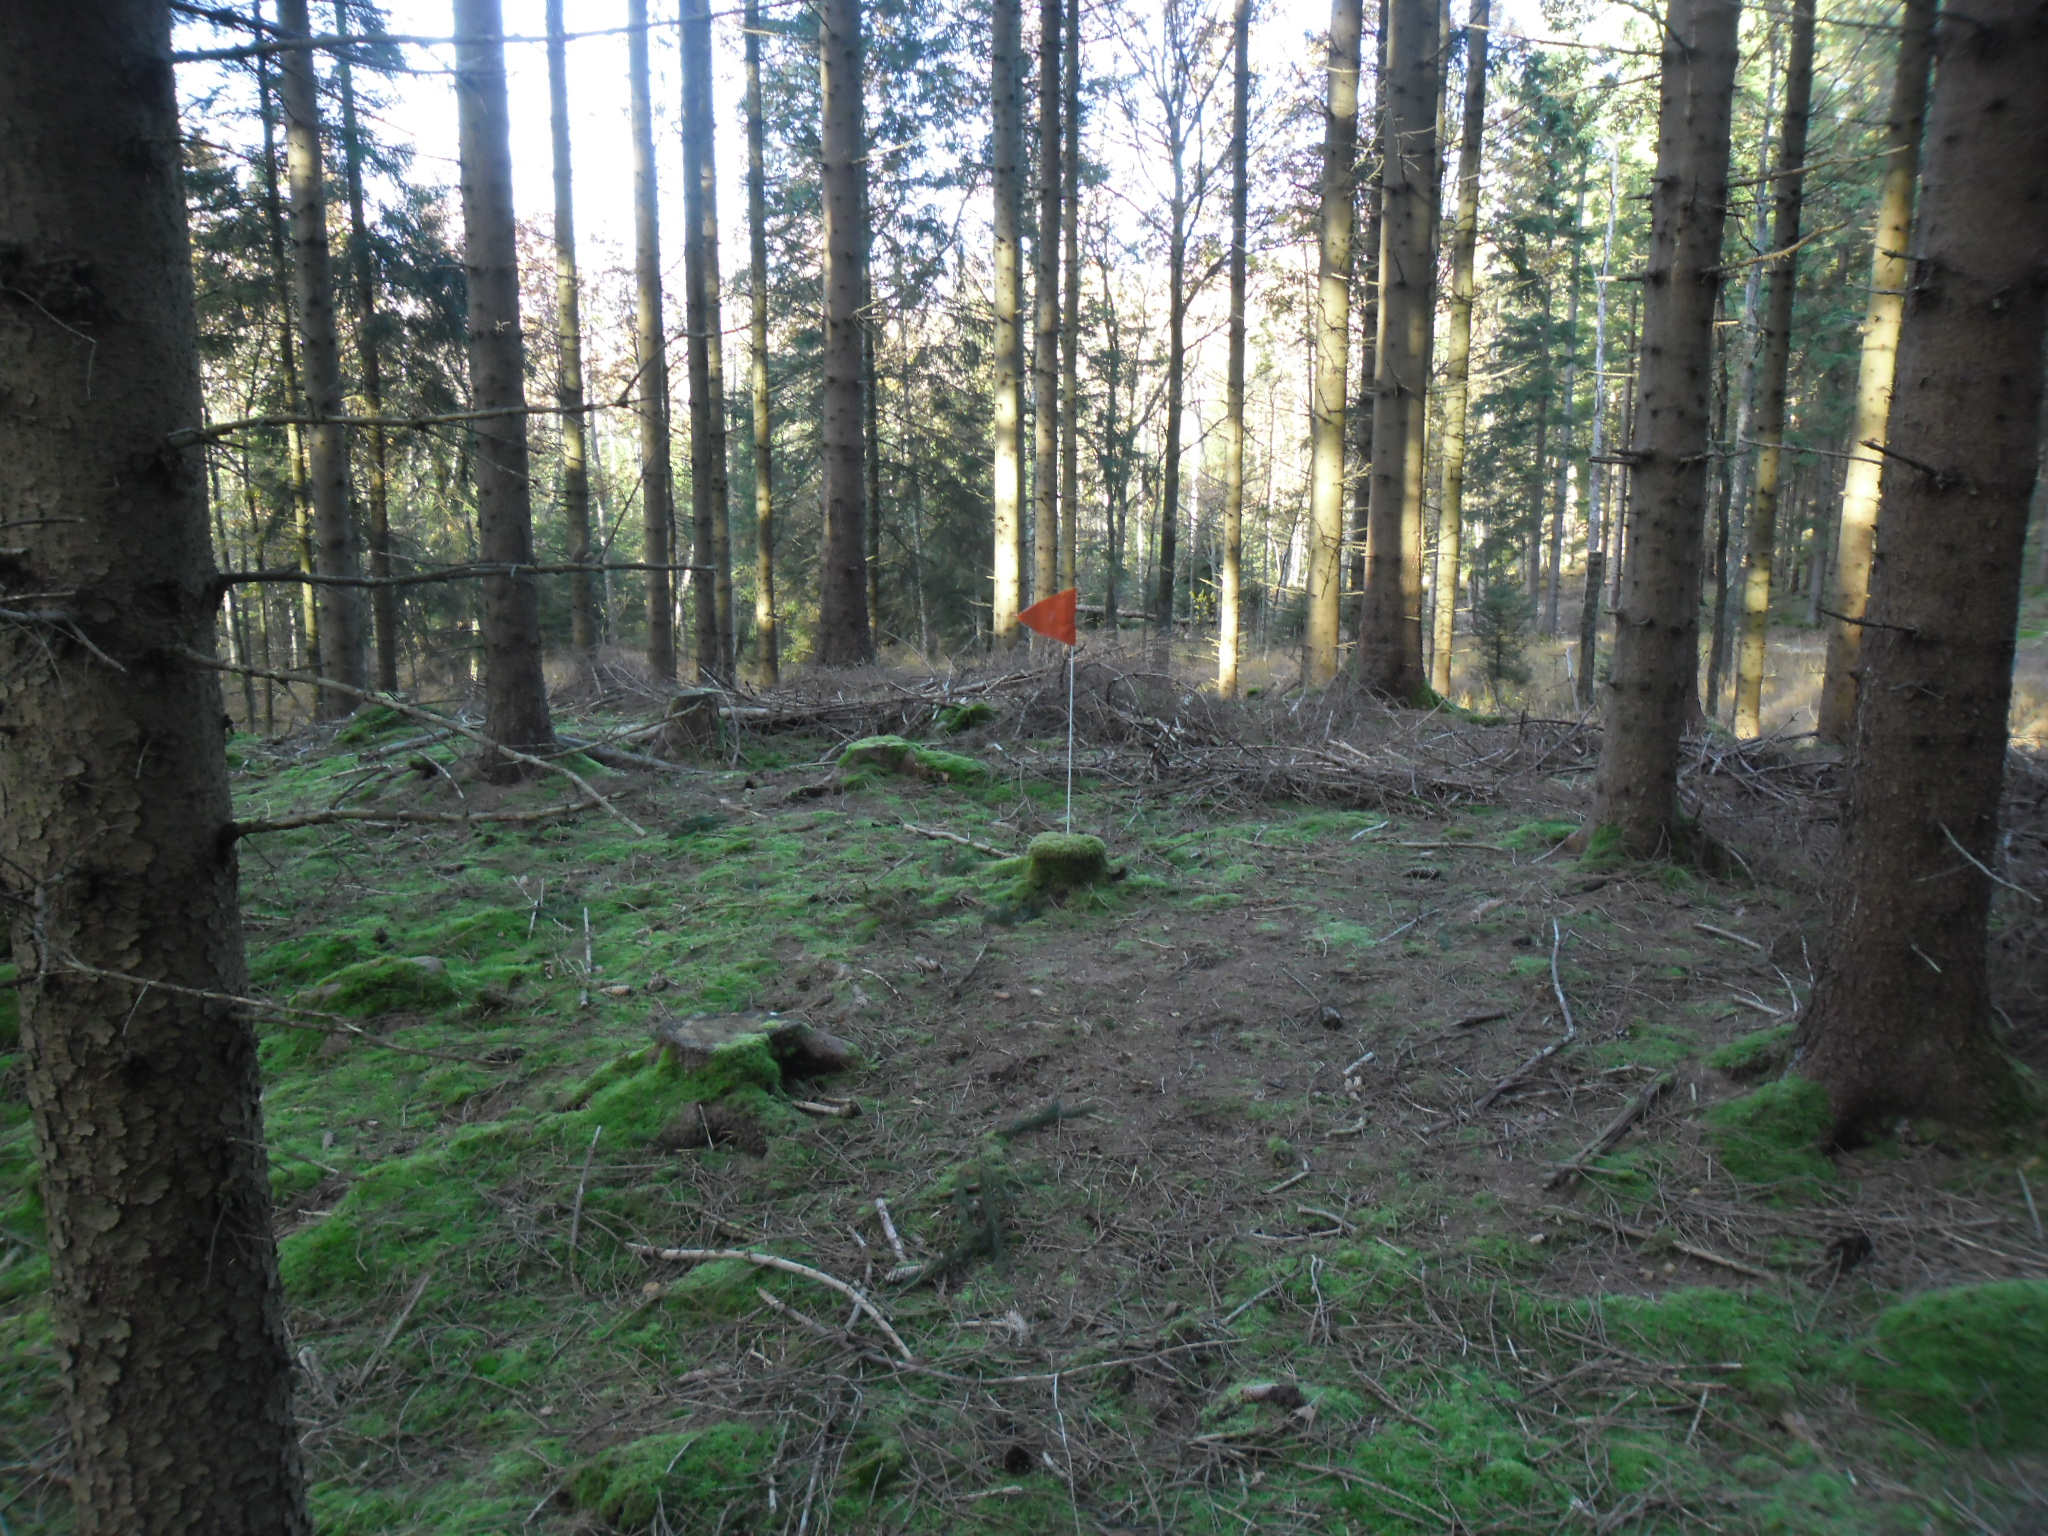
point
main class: Woodland
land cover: Spruce dominated coniferous woodland
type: boreal forest
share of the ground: > 75 %
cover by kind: coniferous forest trees 80 %, lichens and mosses 20 %
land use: Forestry
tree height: > 5 m
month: October
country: SE
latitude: 56.3829
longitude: 13.1553
